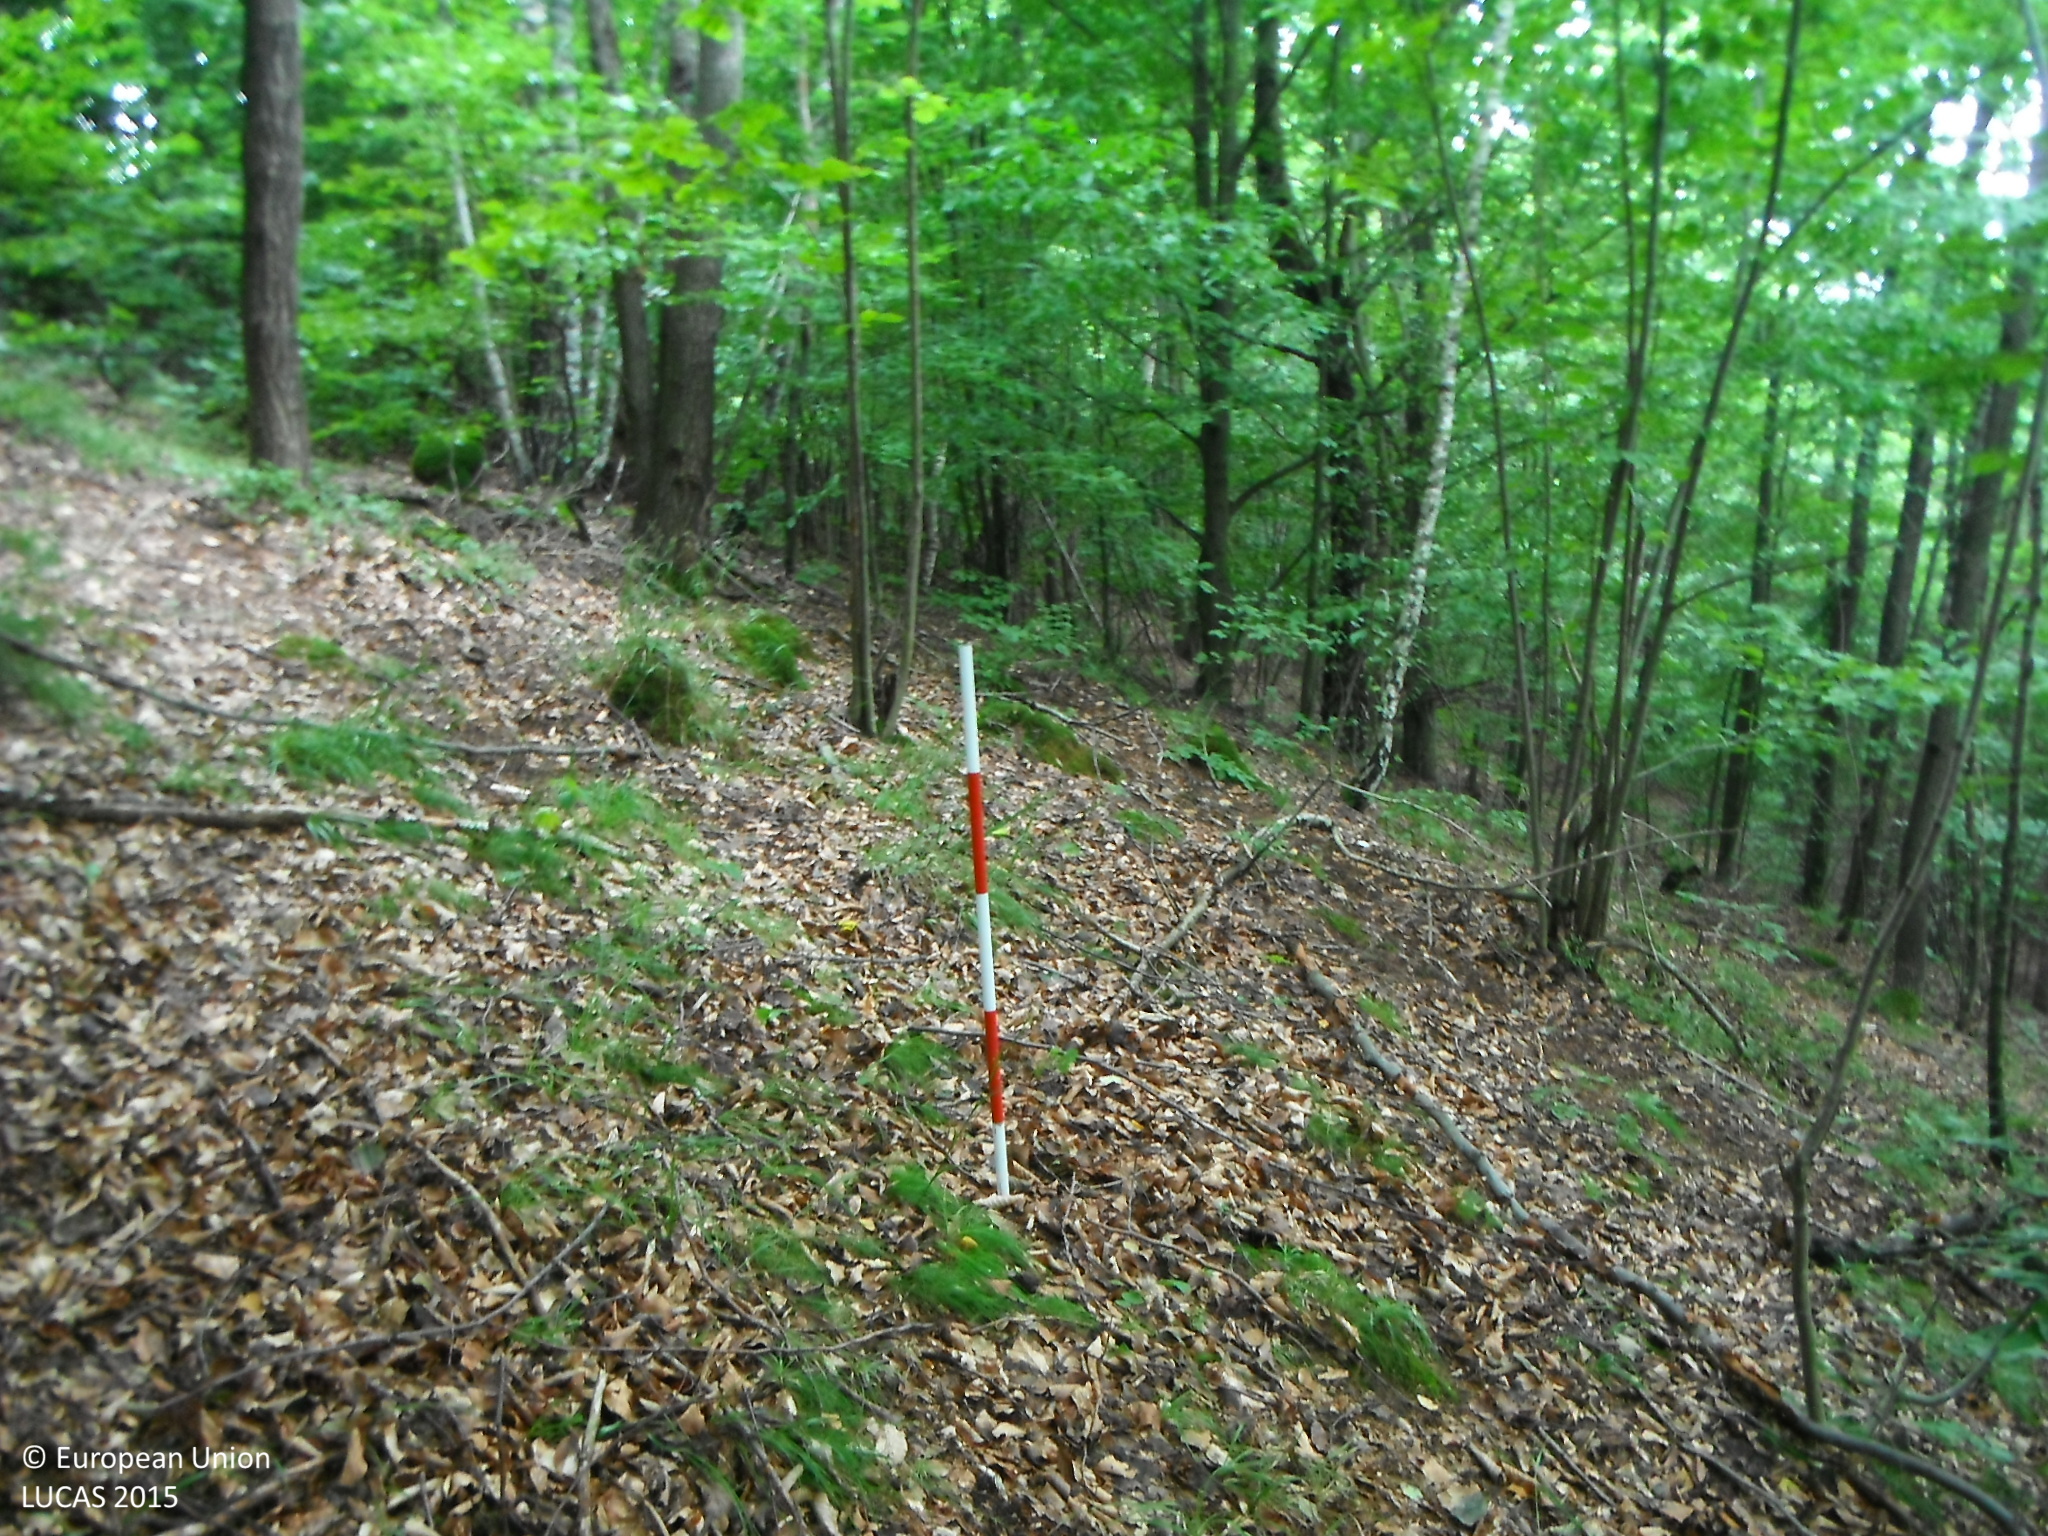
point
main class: Woodland
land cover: Broadleaved woodland
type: beech forest
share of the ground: > 75 %
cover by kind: broadleaved forest trees 100 %
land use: Forestry
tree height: > 5 m
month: July
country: SK
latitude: 48.8307
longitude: 20.8424
